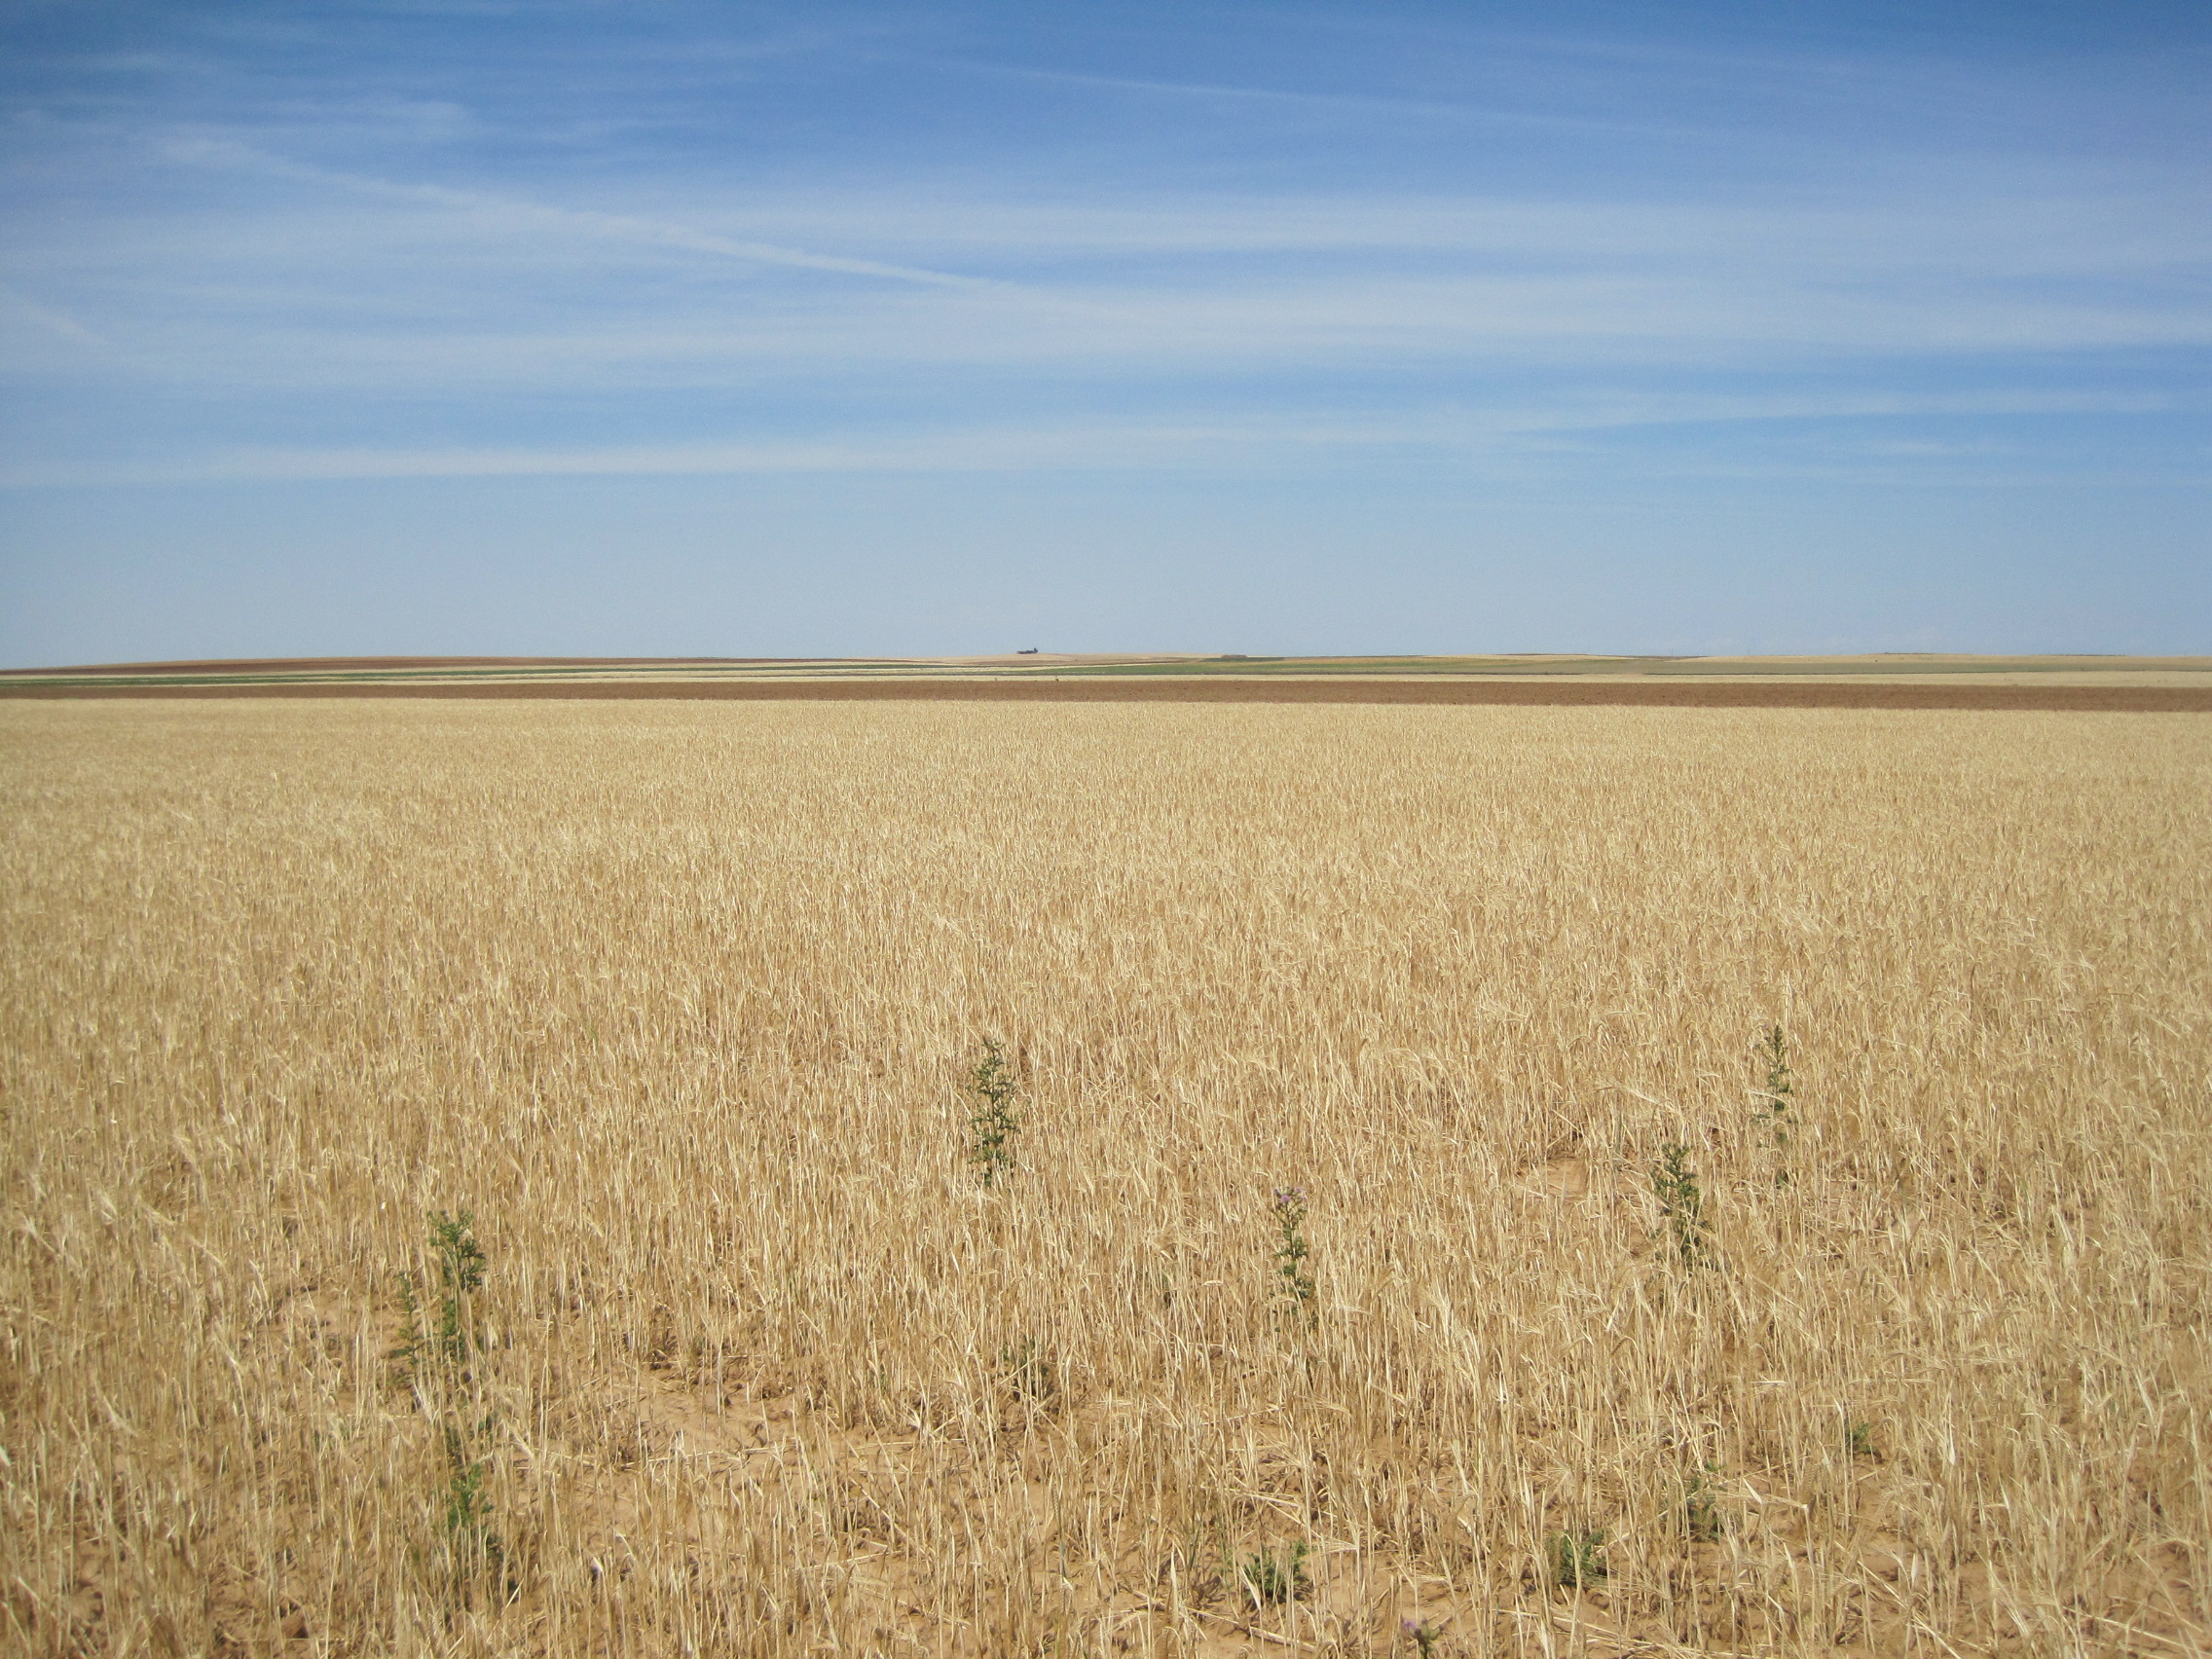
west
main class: Cropland
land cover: Barley
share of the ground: > 75 %
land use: Agriculture (excluding fallow land and kitchen gardens)
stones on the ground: < 10 %
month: June
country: ES
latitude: 41.8058
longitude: -5.2340
